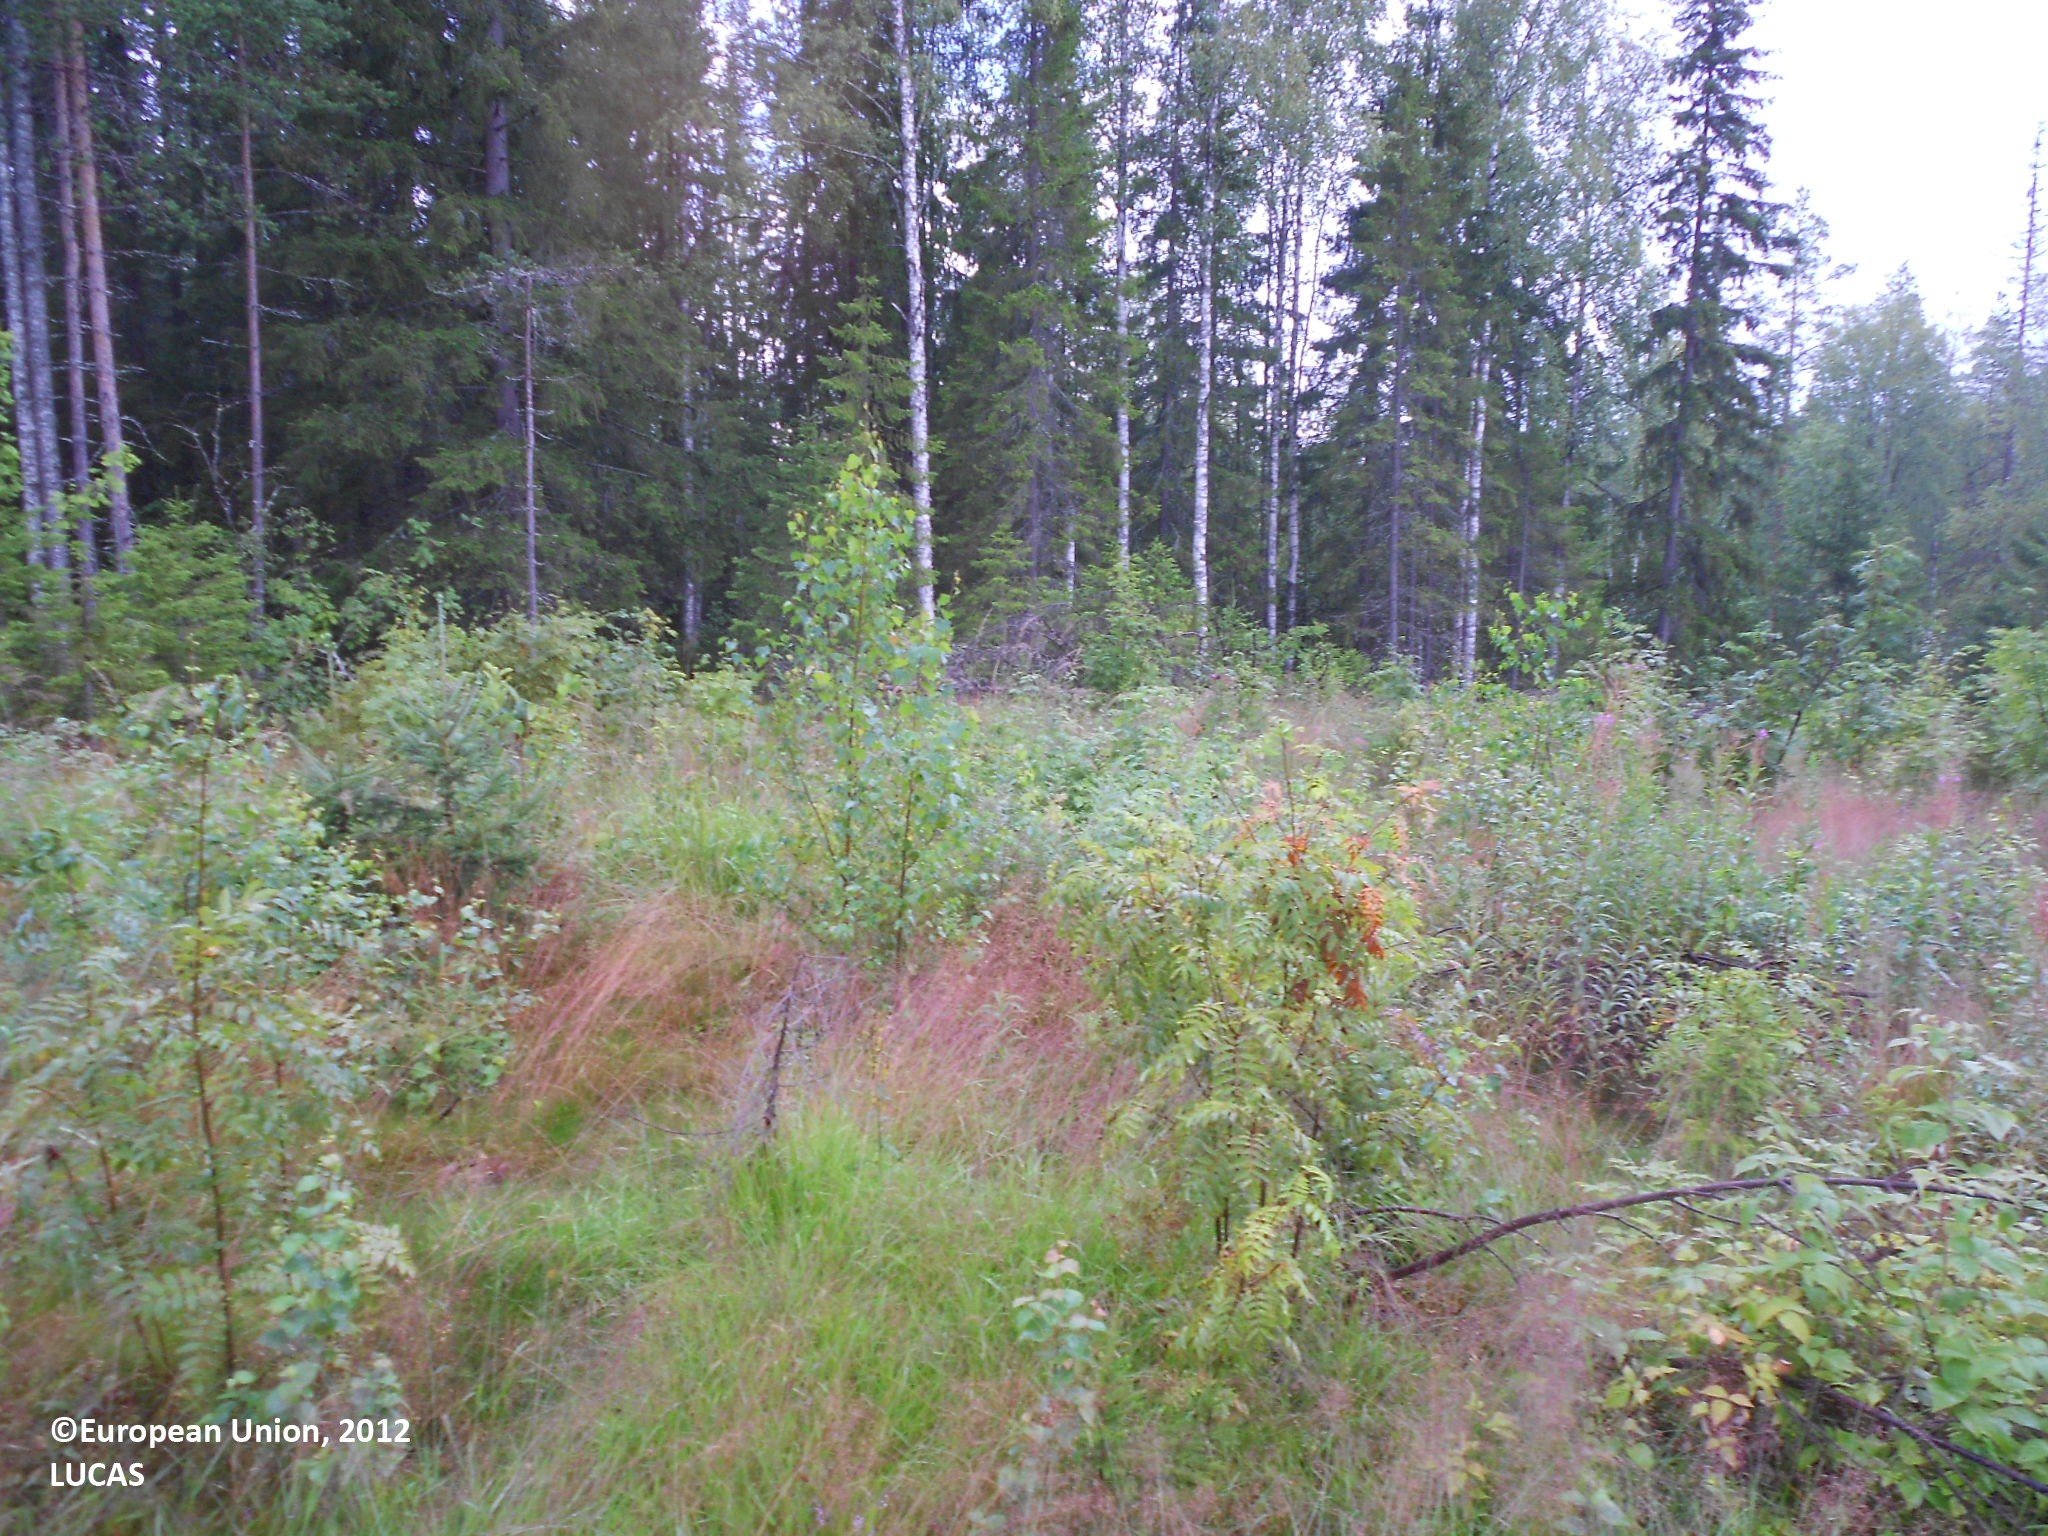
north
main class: Shrubland
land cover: Shrubland with sparse tree cover
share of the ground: > 75 %
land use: Forestry
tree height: < 5 m
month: August
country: FI
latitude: 63.4582
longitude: 28.3786
